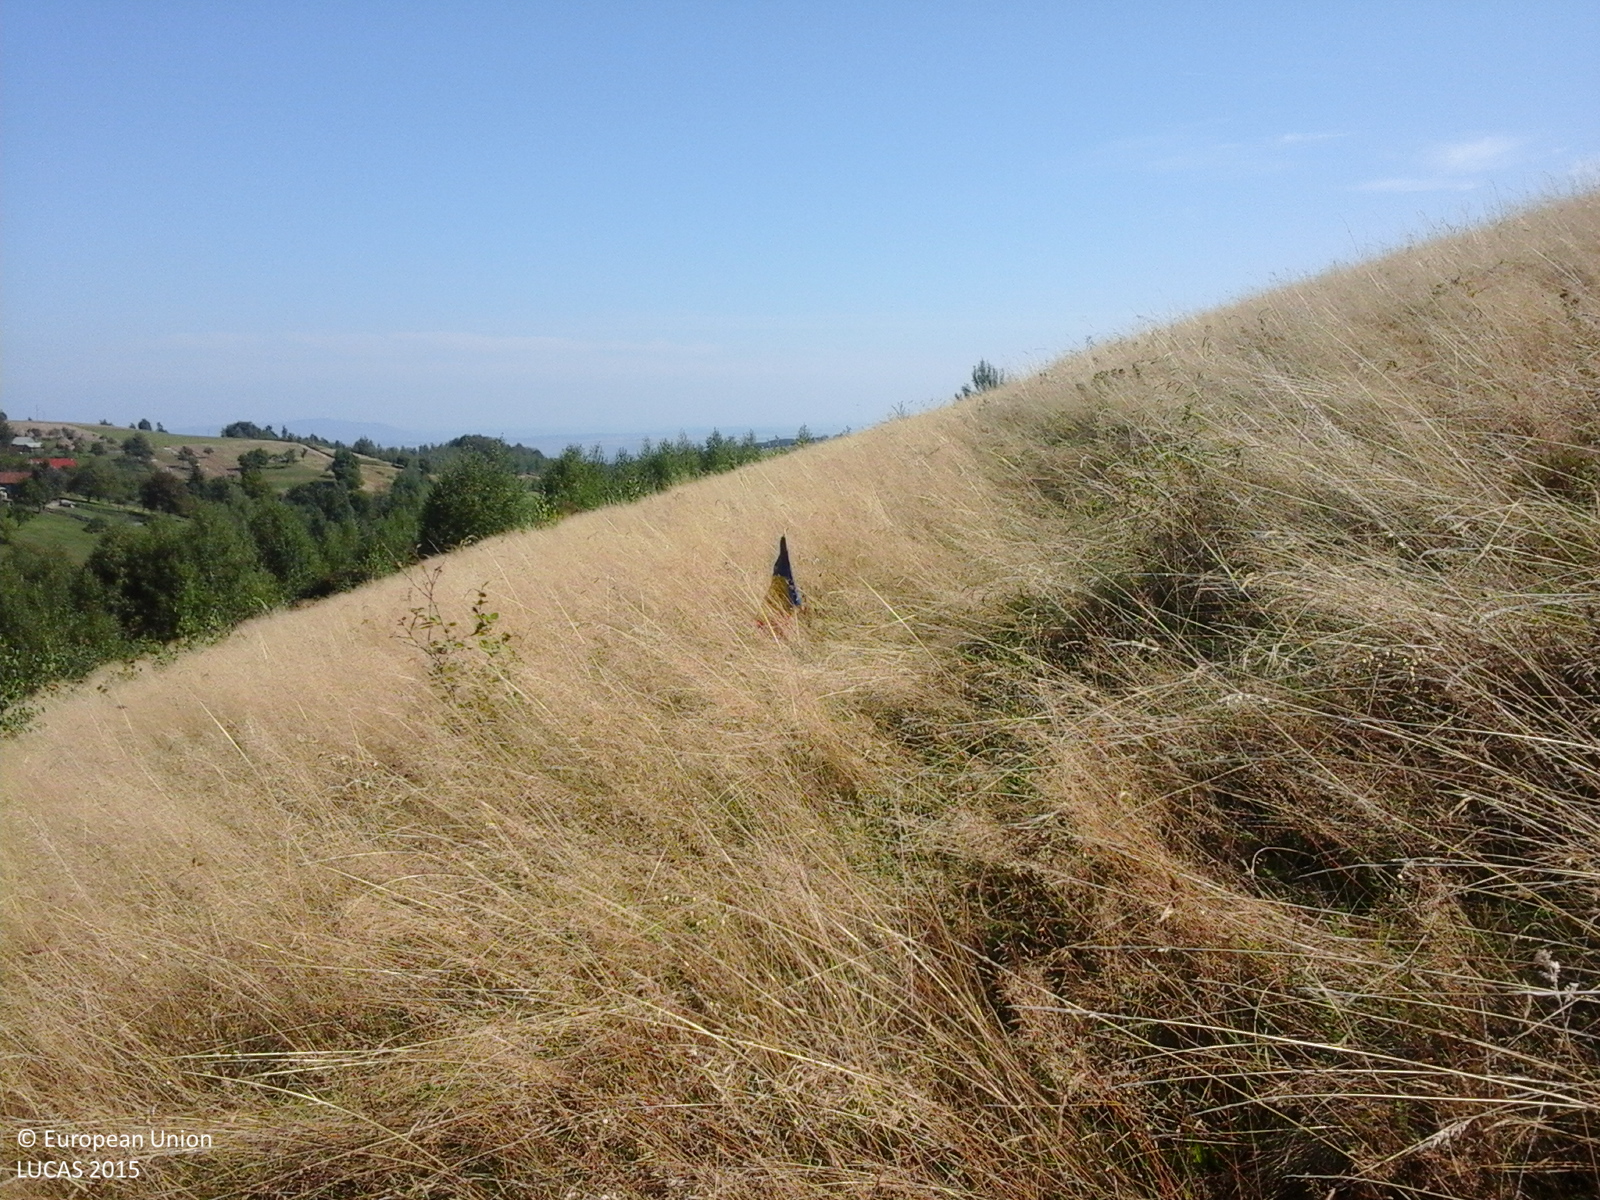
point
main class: Grassland
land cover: Grassland with sparse tree/shrub cover
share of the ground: > 75 %
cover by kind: herbaceous plants 85 %, shrubs 10 %, broadleaved forest trees 5 %
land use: Agriculture (excluding fallow land and kitchen gardens)
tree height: < 5 m
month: September
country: RO
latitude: 47.1043
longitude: 22.5338
